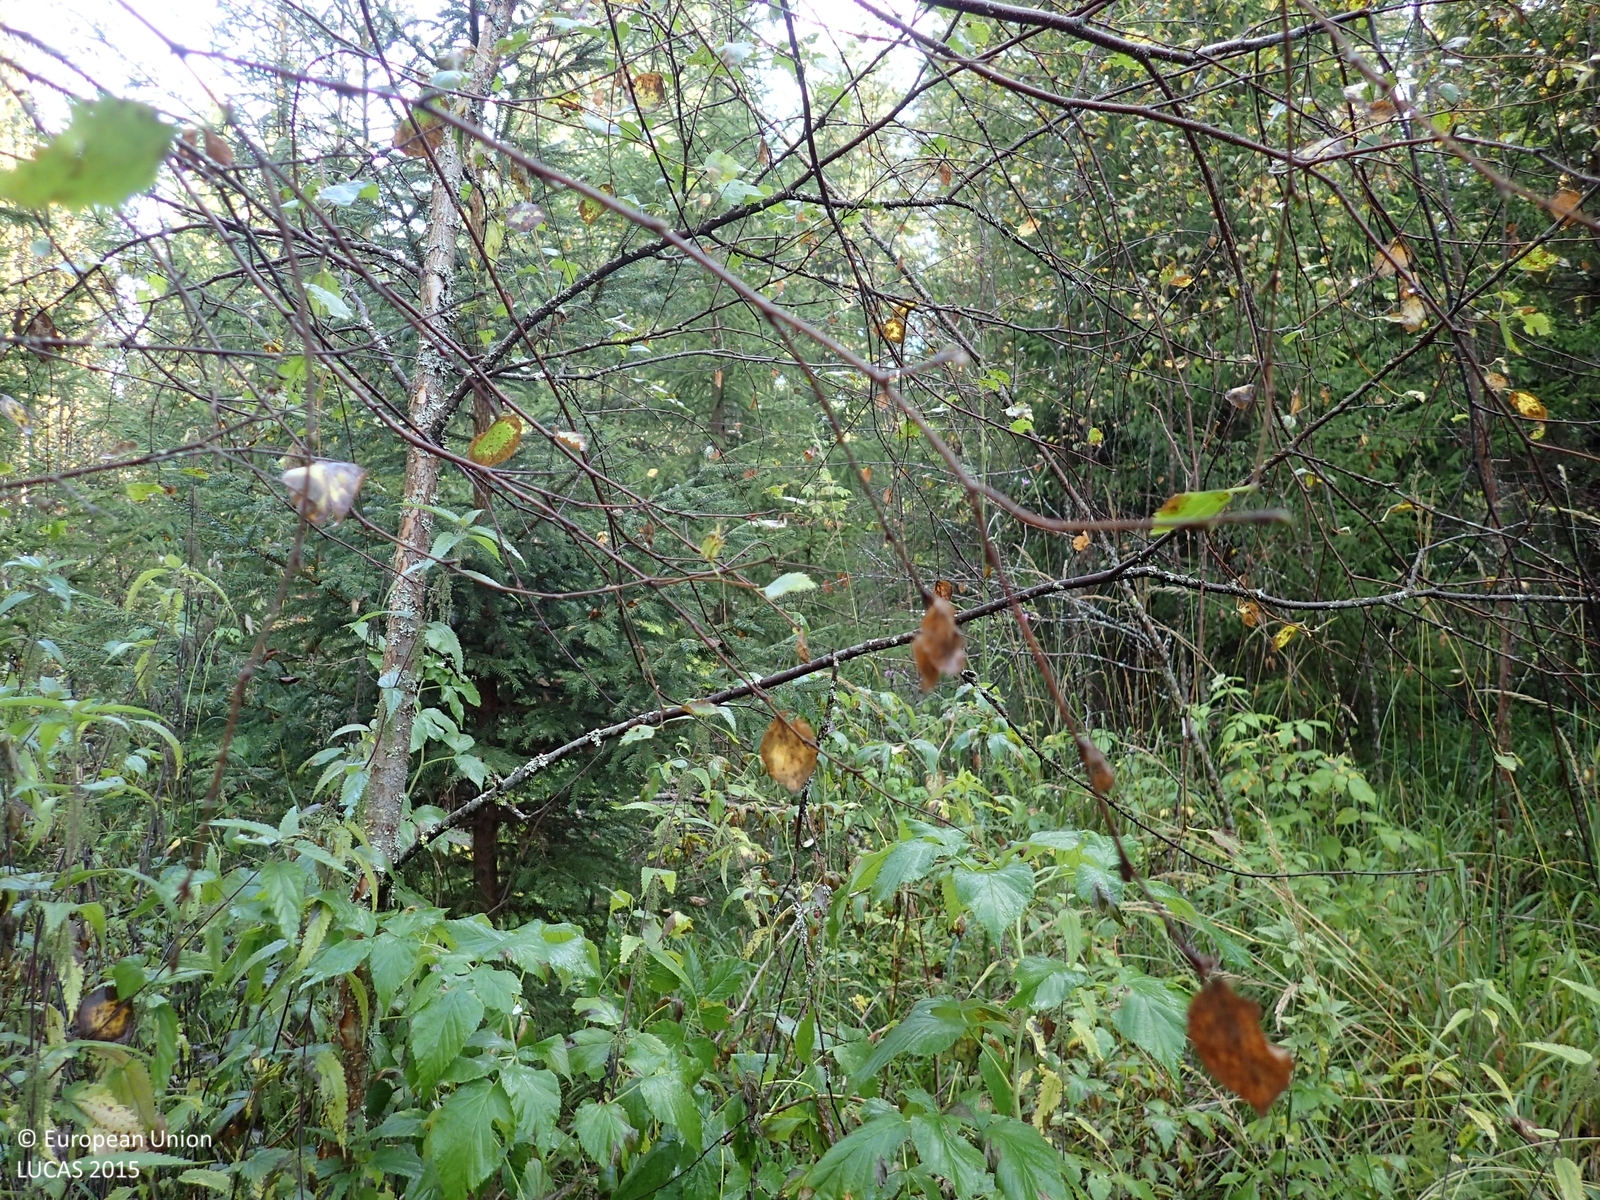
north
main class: Woodland
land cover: Spruce dominated mixed woodland
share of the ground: > 75 %
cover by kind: coniferous forest trees 55 %, herbaceous plants 25 %, broadleaved forest trees 20 %
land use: Forestry
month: September
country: FI
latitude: 63.0125
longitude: 25.5742
